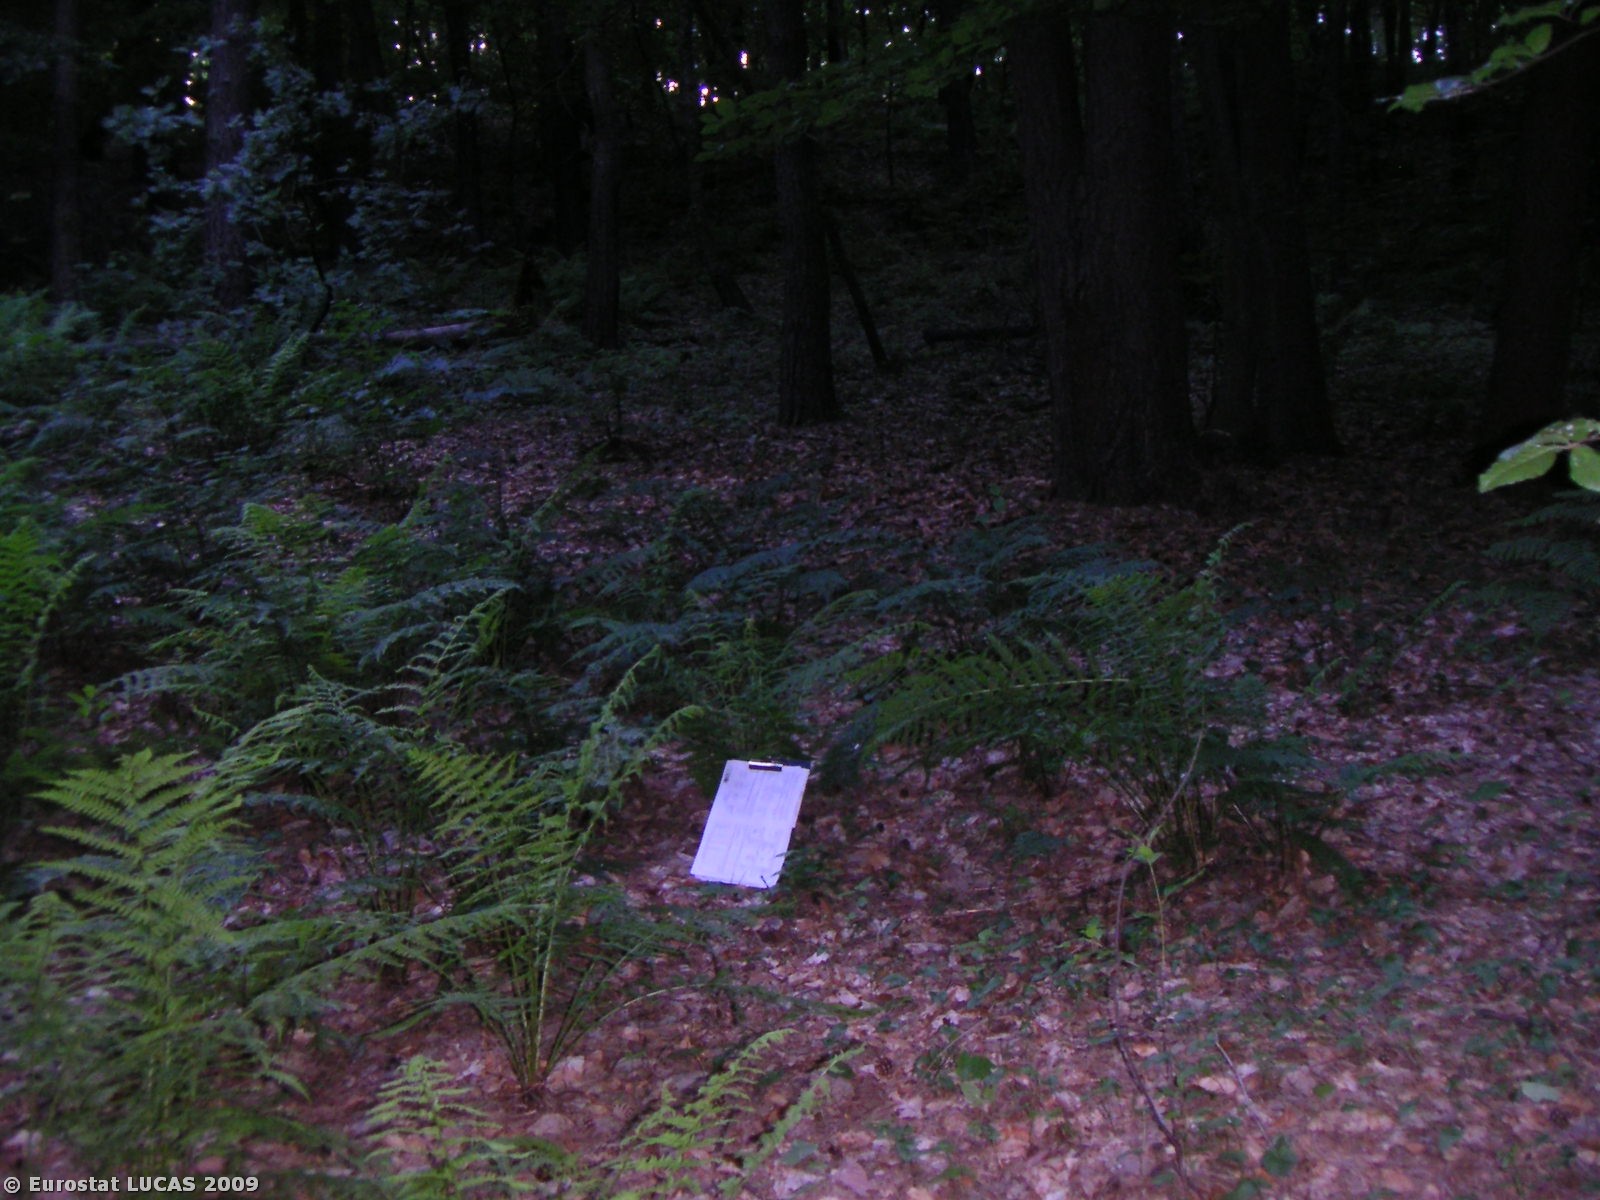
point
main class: Woodland
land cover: Mixed woodland
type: hemiboreal forest and nemoral coniferous forest and mixed broadleaved-coniferous forest
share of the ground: > 75 %
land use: Forestry
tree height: > 5 m
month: June
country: PL
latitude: 50.1098
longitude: 19.7479
